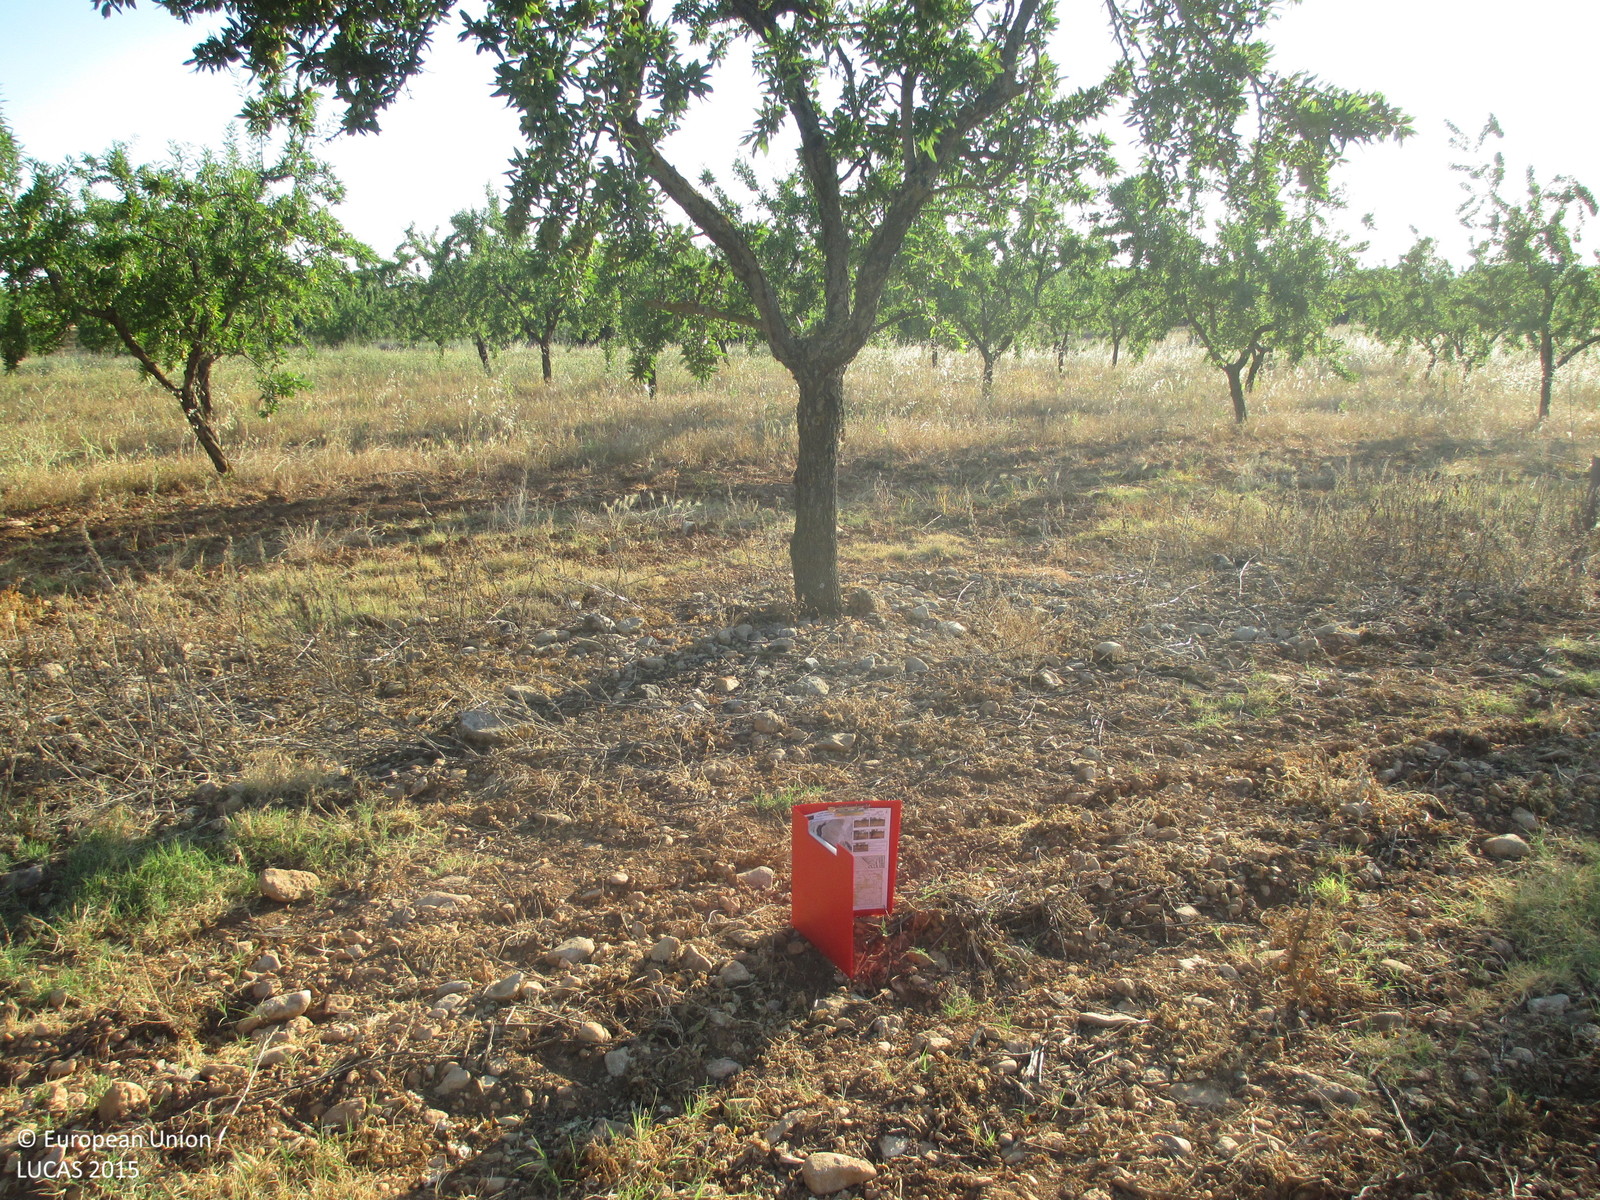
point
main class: Cropland
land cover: Nuts trees
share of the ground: > 75 %
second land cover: Other bare soil
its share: > 75 %
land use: Agriculture (excluding fallow land and kitchen gardens)
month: June
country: ES
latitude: 42.1169
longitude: -0.0467
